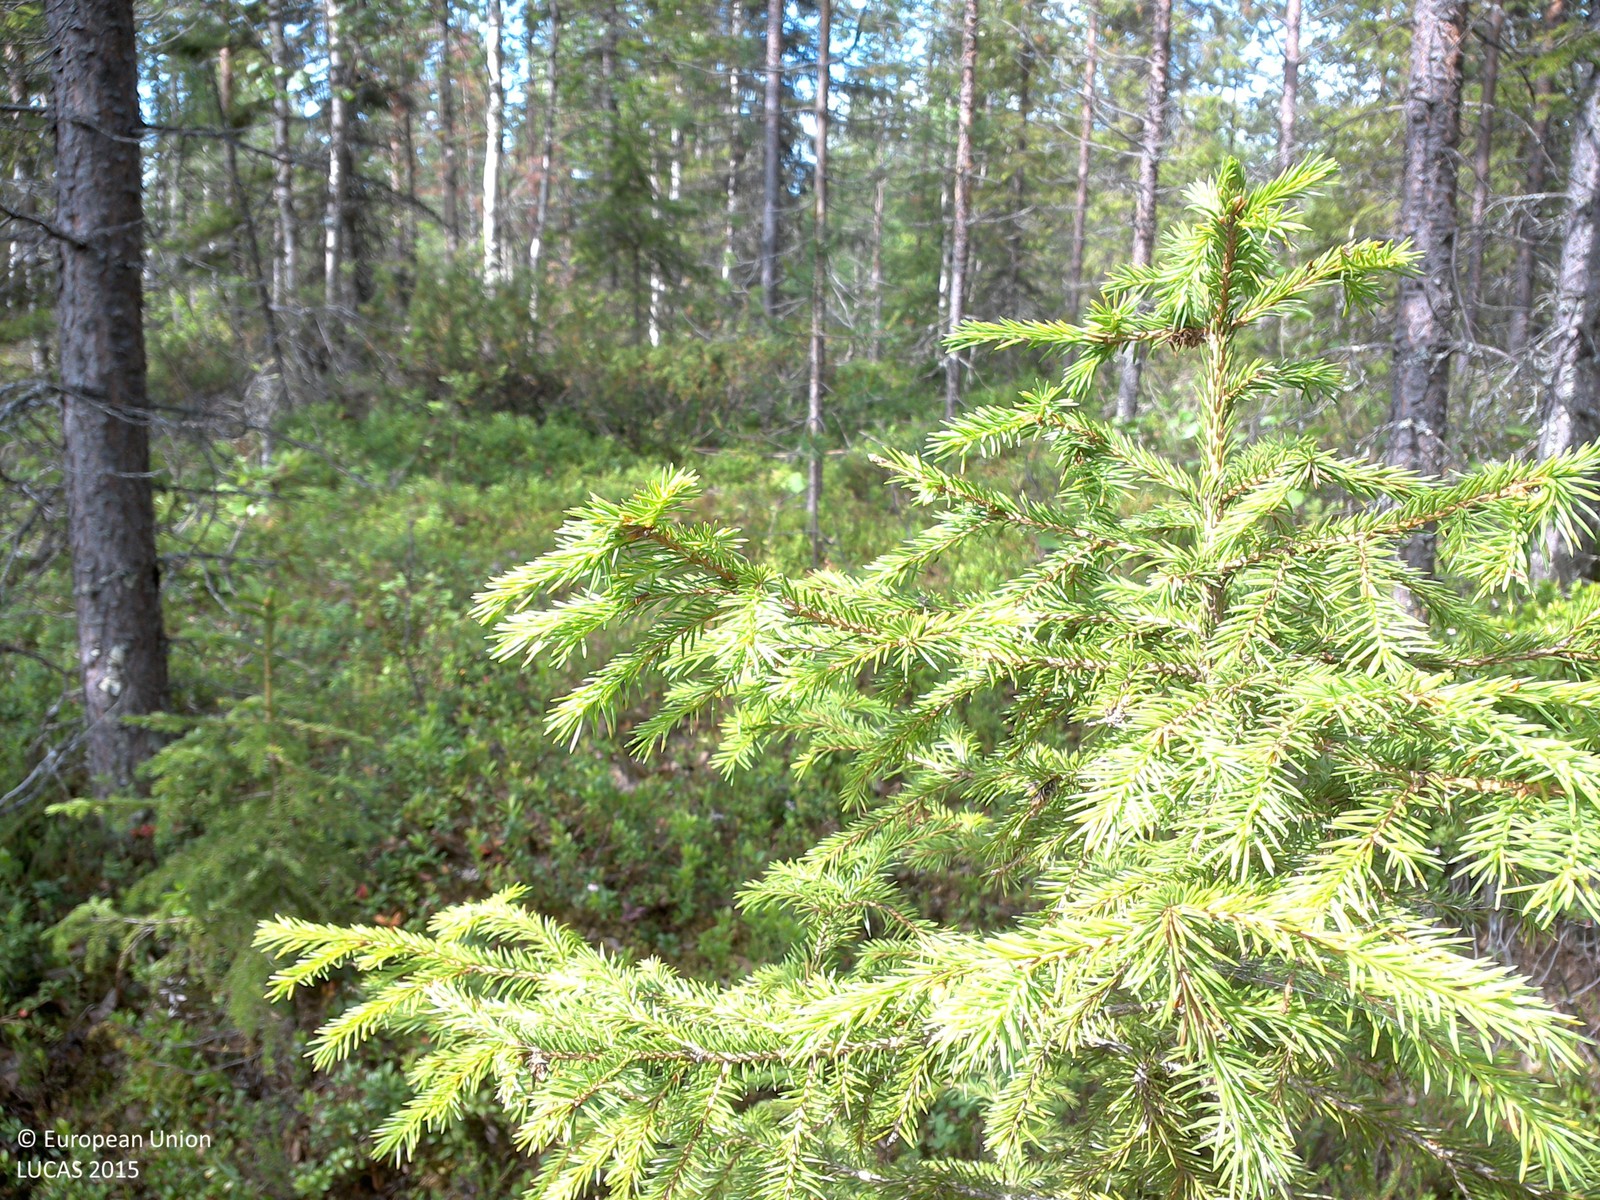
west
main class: Woodland
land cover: Pine dominated mixed woodland
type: boreal forest
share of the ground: 25 - 50 %
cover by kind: shrubs 65 %, coniferous forest trees 25 %, broadleaved forest trees 10 %
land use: Forestry
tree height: > 5 m
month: July
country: SE
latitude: 67.2154
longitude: 23.1352
